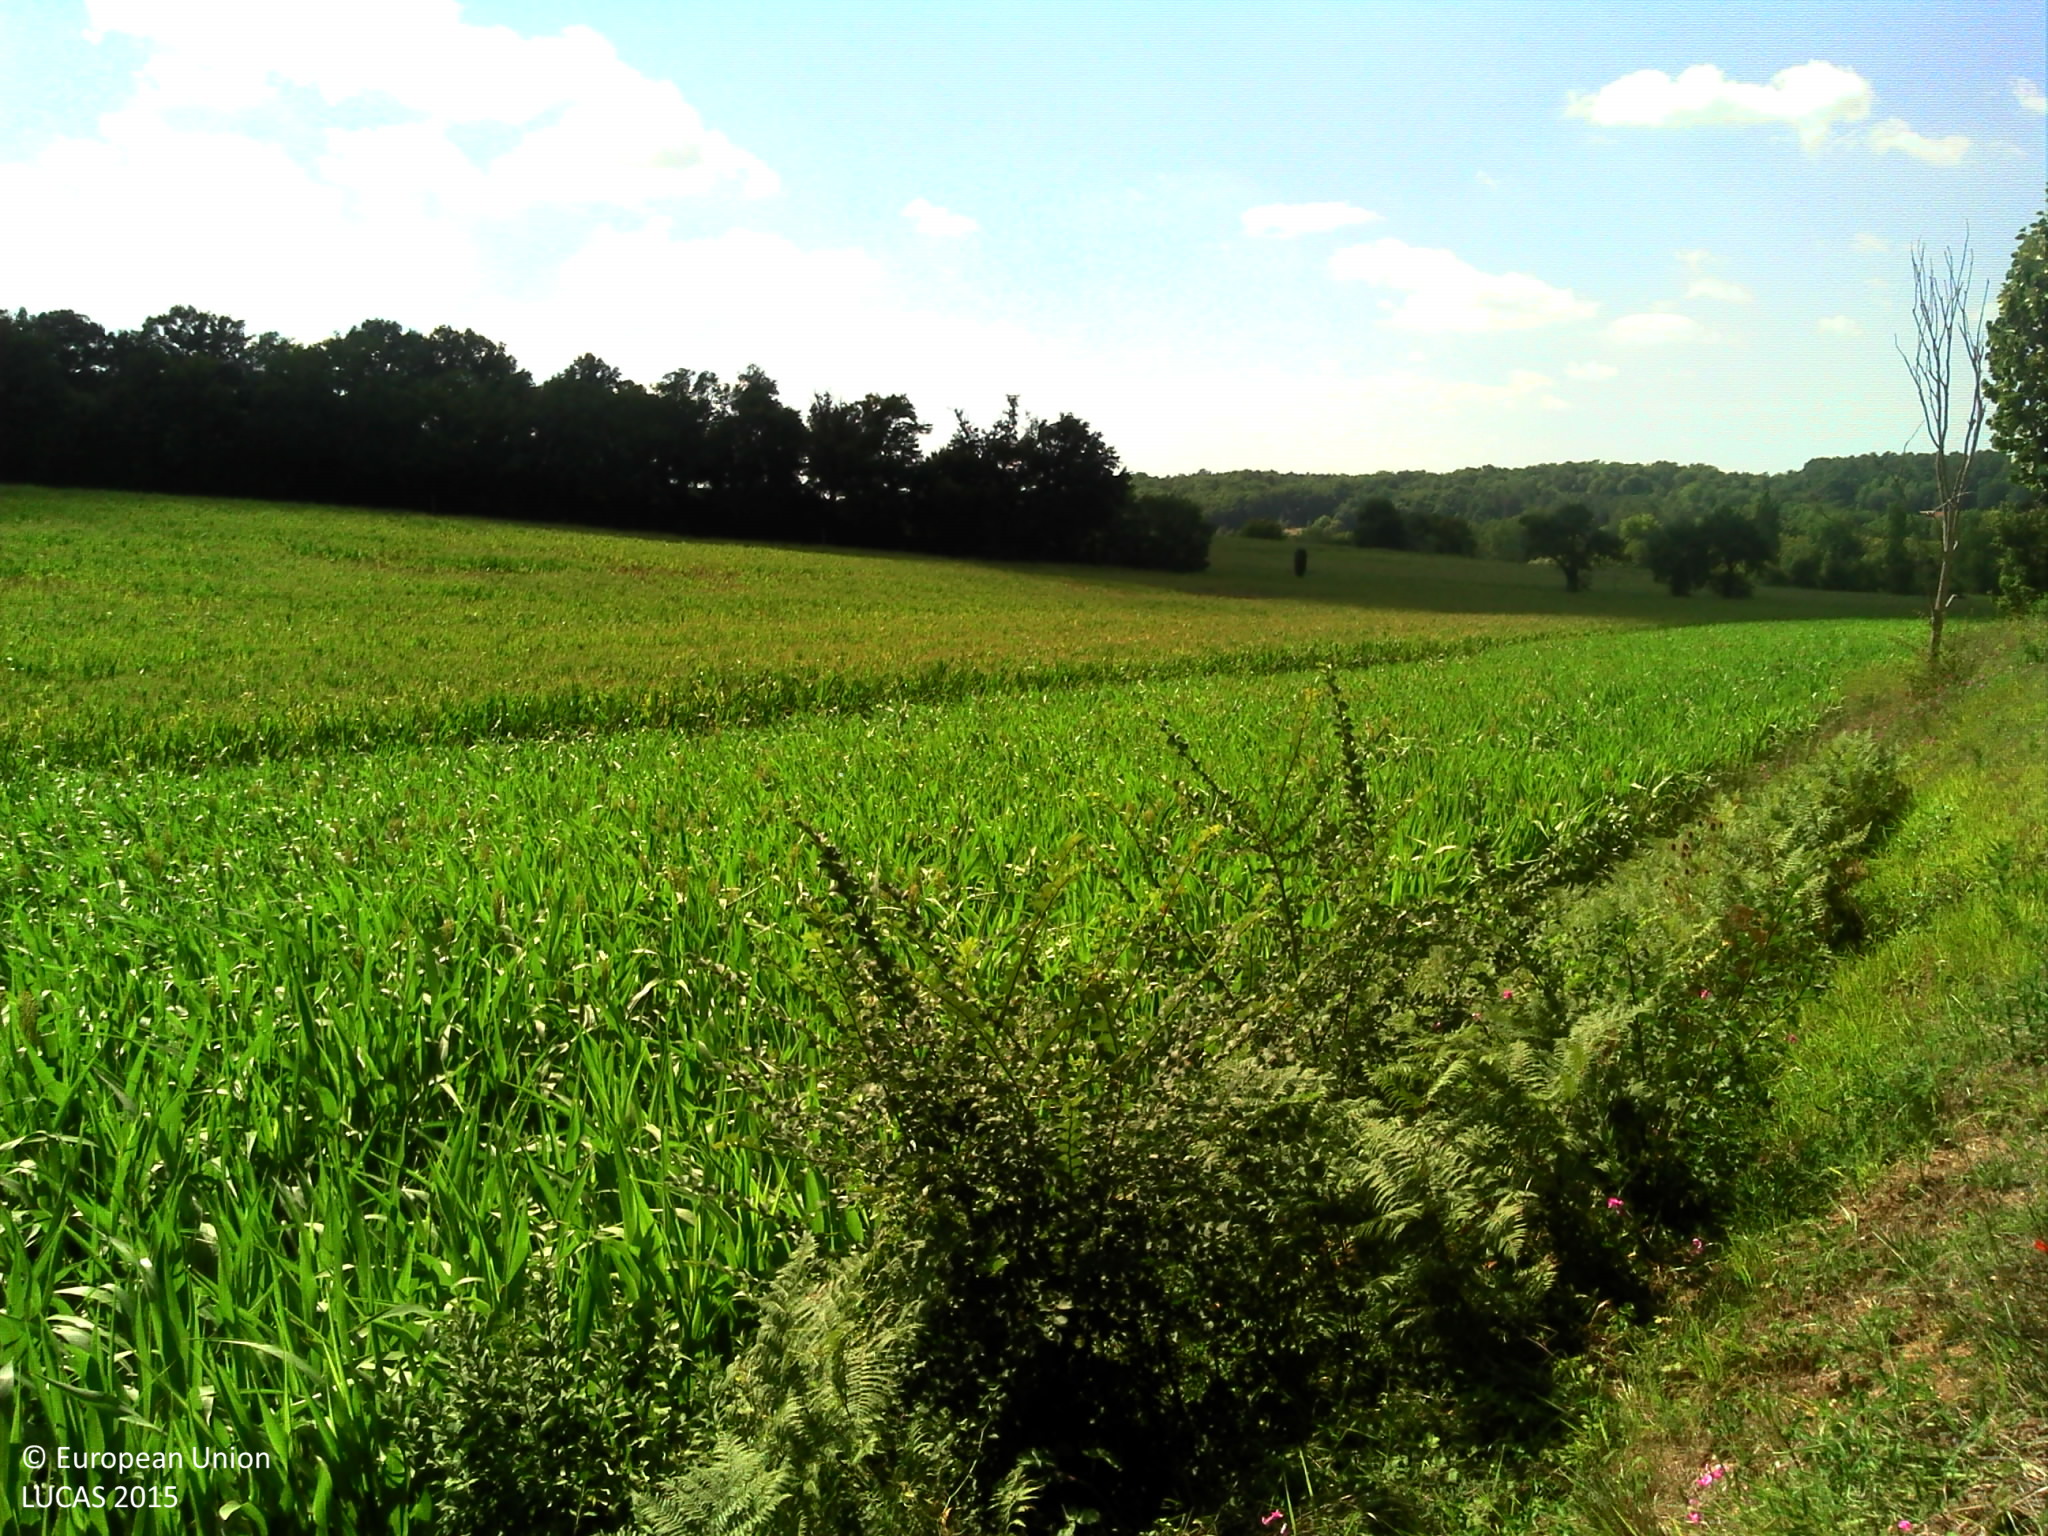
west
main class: Cropland
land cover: Maize
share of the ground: > 75 %
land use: Agriculture (excluding fallow land and kitchen gardens)
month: August
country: FR
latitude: 45.2787
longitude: 0.7477
